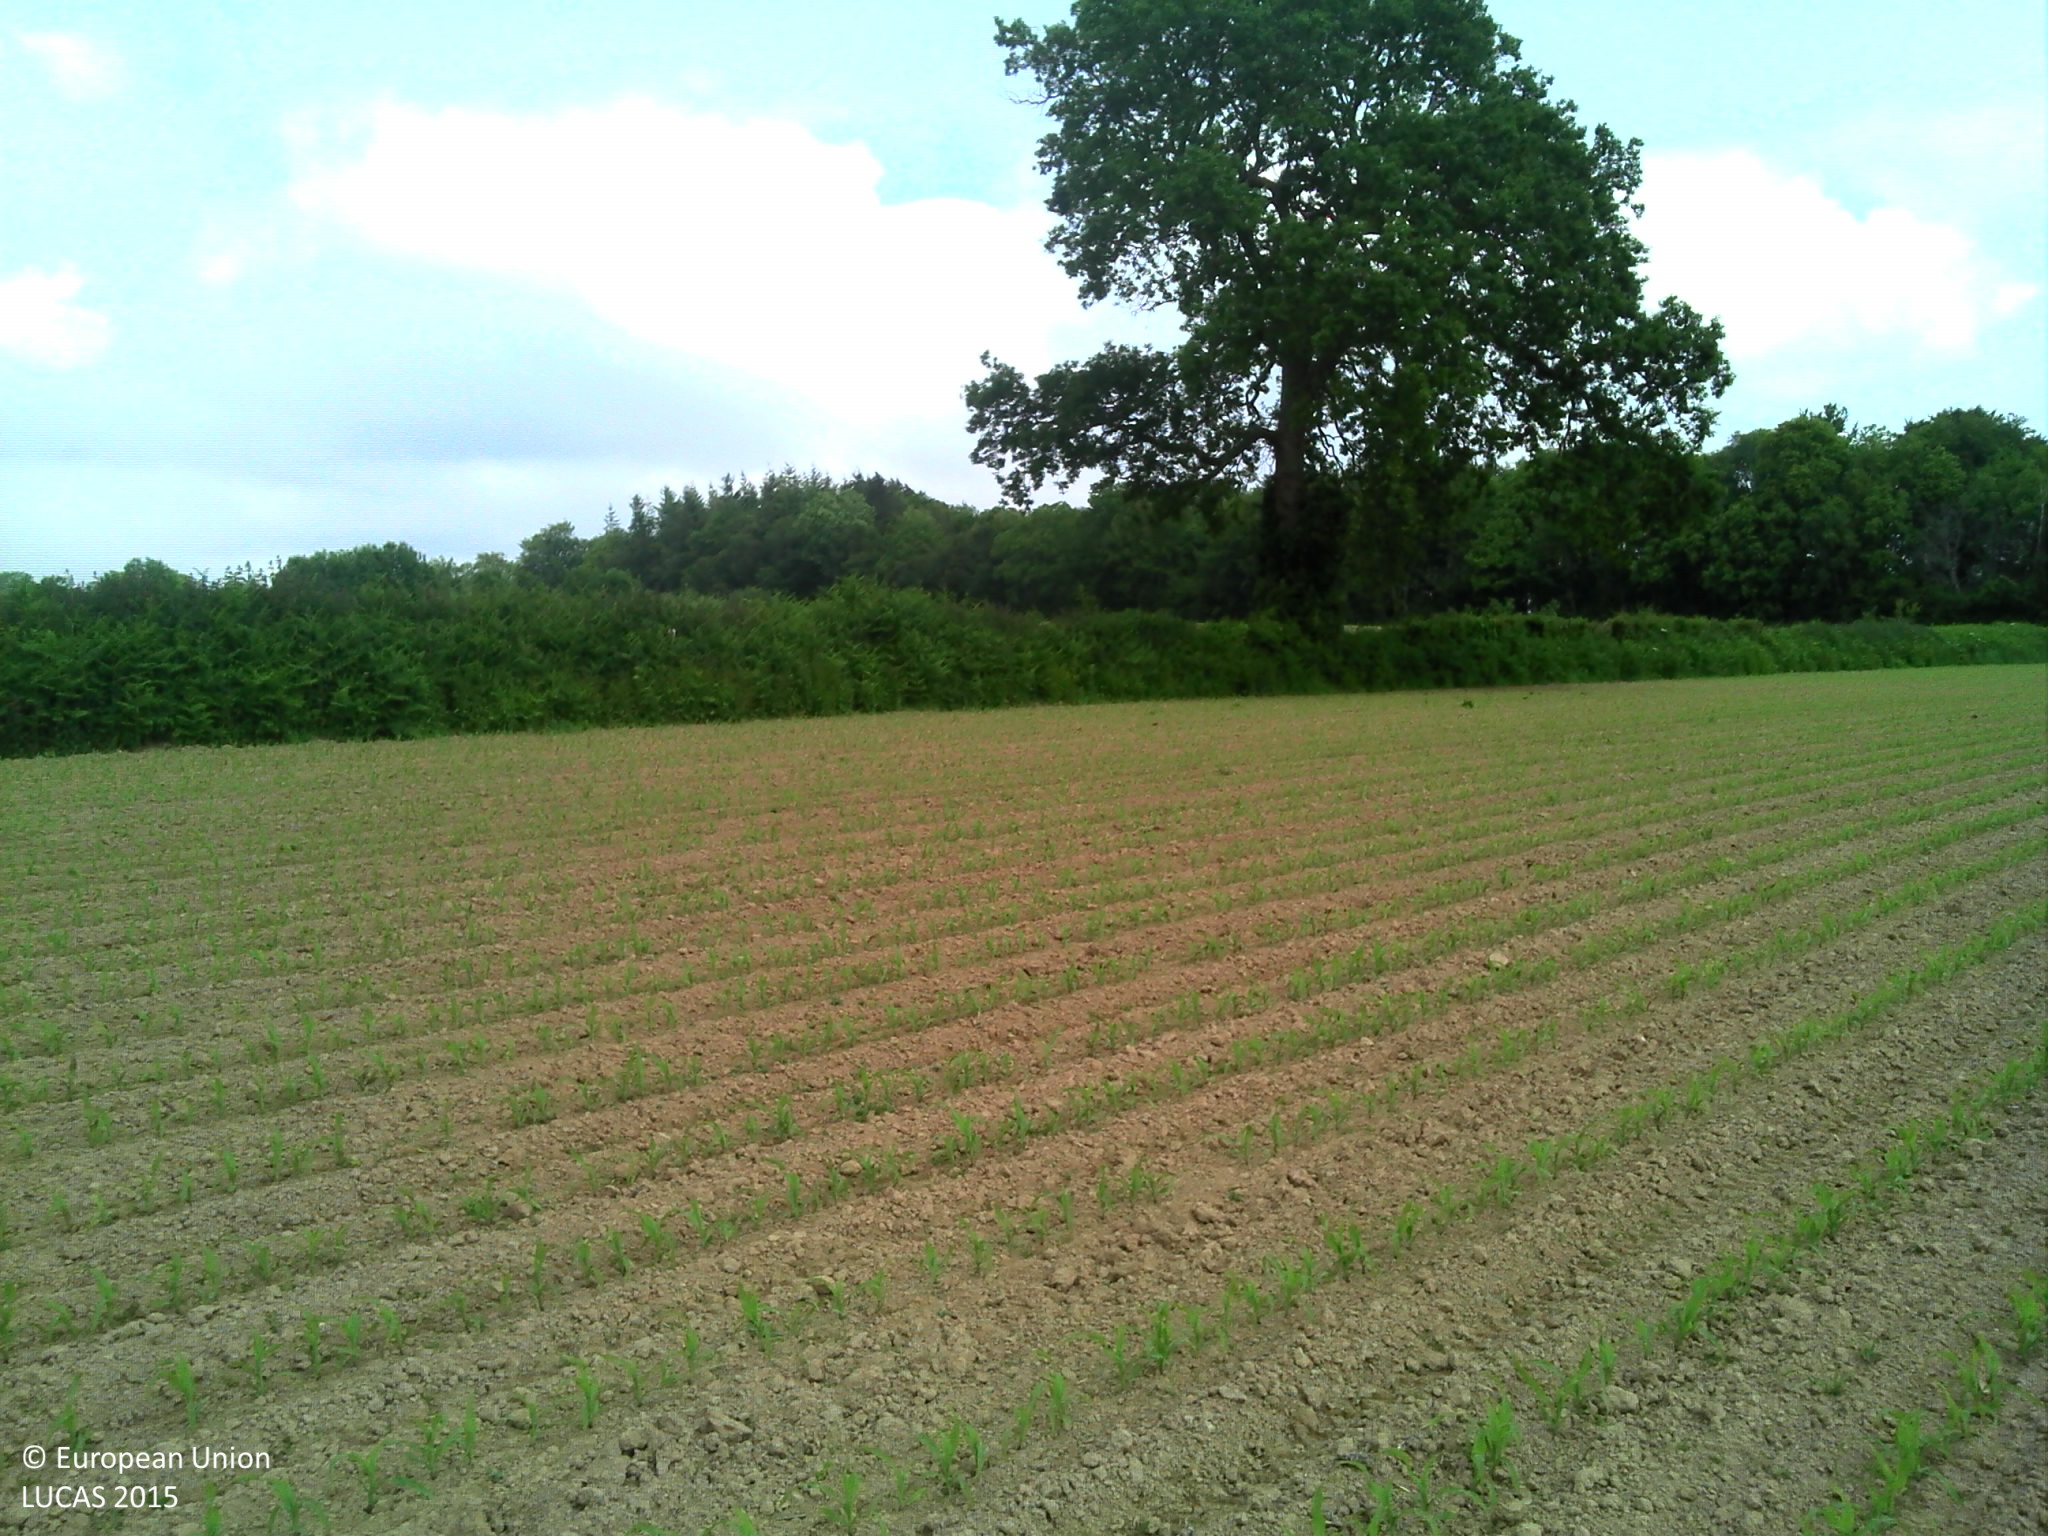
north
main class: Cropland
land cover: Maize
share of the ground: < 10 %
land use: Agriculture (excluding fallow land and kitchen gardens)
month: June
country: FR
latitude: 49.5449
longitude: -1.5069
